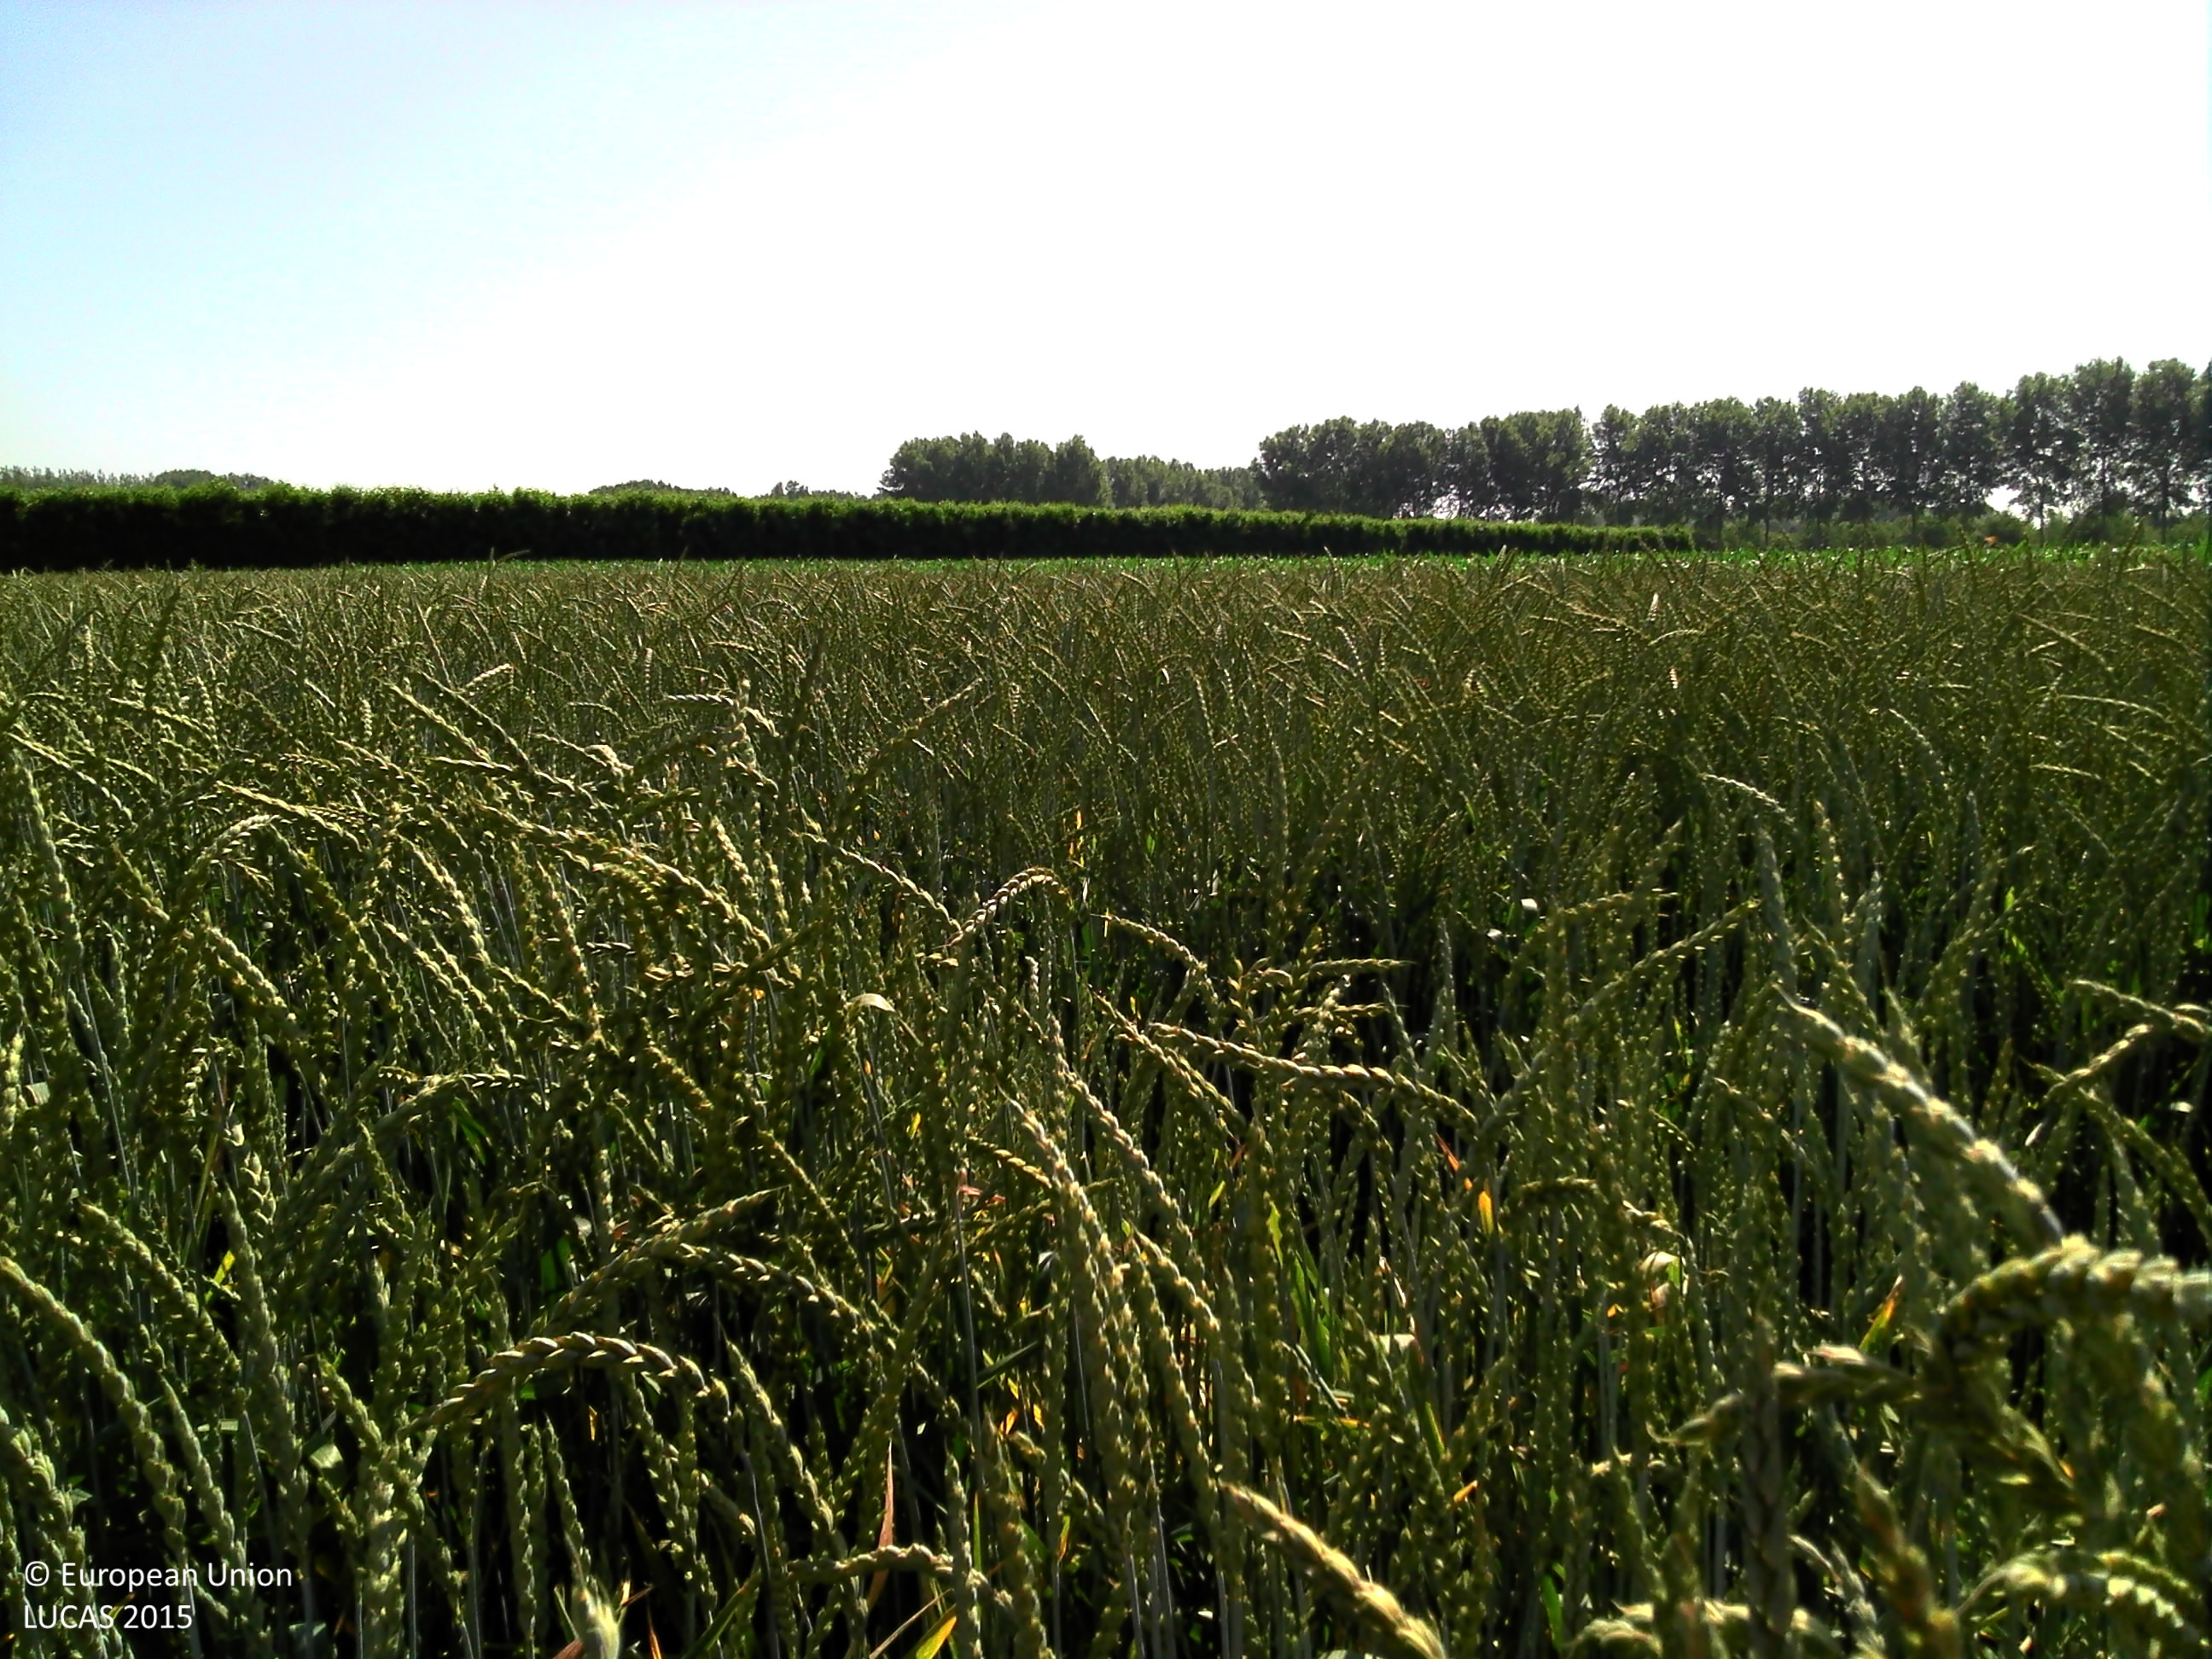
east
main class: Cropland
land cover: Common wheat
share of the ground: > 75 %
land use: Agriculture (excluding fallow land and kitchen gardens)
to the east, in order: Common wheat; Maize; Managed hedges; Tracks; Apple fruit; Maize
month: June
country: BE
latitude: 50.8199
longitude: 5.1571
